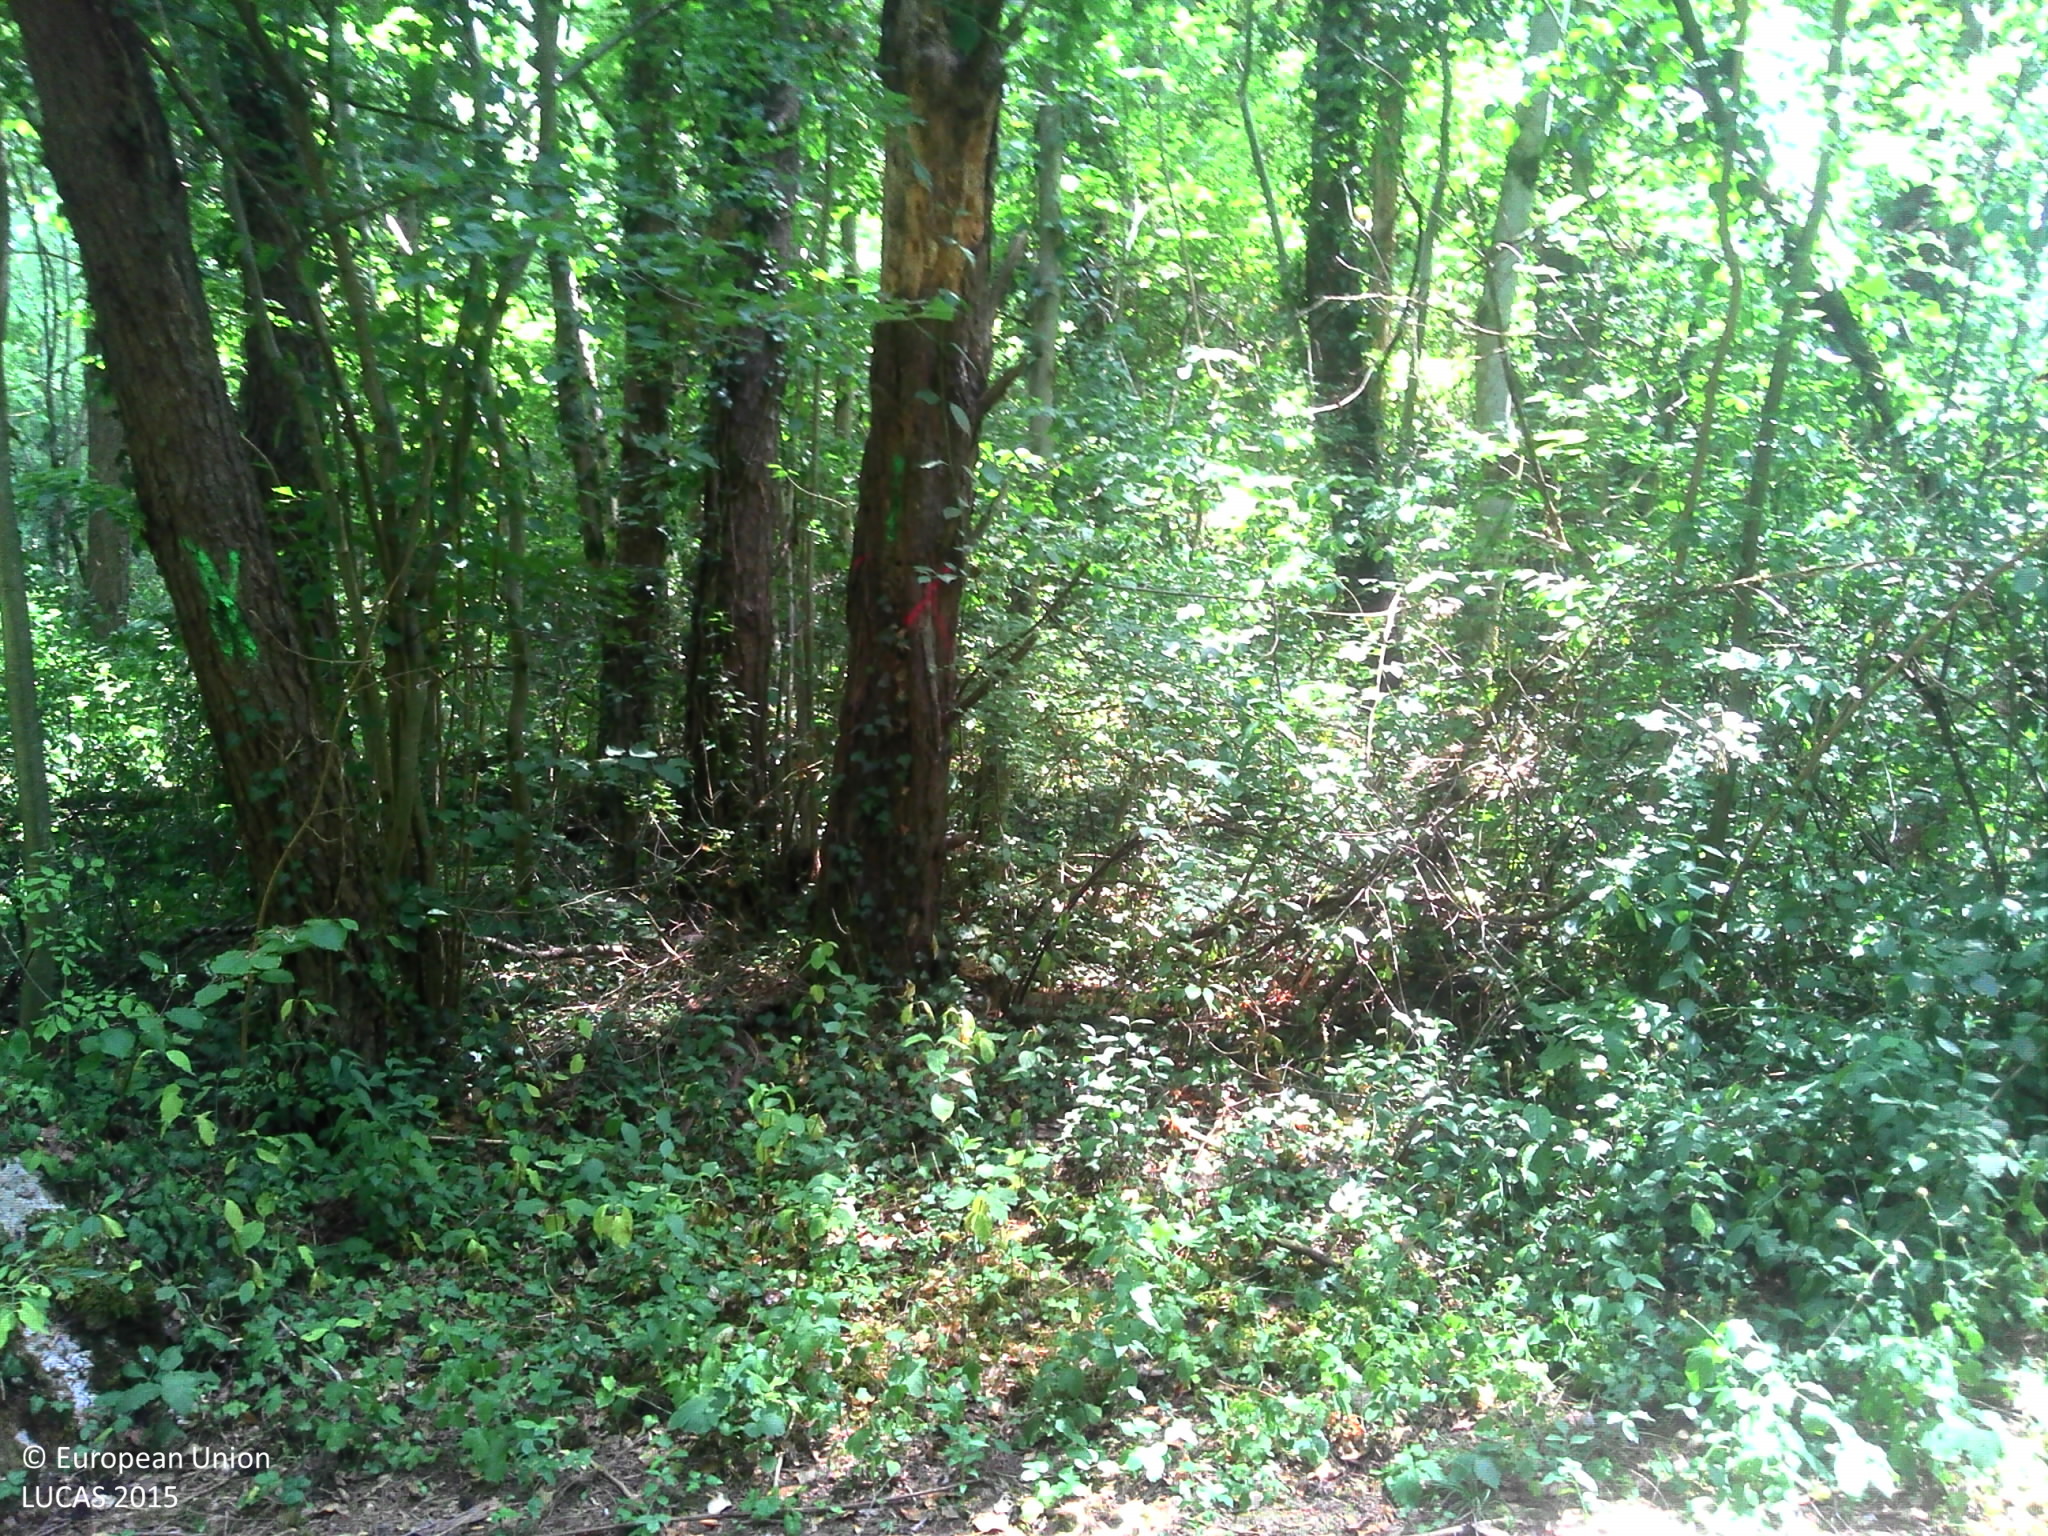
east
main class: Woodland
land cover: Pine dominated mixed woodland
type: hemiboreal forest and nemoral coniferous forest and mixed broadleaved-coniferous forest
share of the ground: > 75 %
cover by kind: coniferous forest trees 30 %, broadleaved forest trees 30 %, herbaceous plants 25 %, lichens and mosses 10 %, shrubs 5 %
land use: Forestry
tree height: > 5 m
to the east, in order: Pine dominated mixed woodland; Grass margins; Paved roads, cycling and walking lanes; Grass margins; Pine dominated mixed woodland; Tracks; Pine dominated mixed woodland
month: July
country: FR
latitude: 46.1246
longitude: 6.2894
